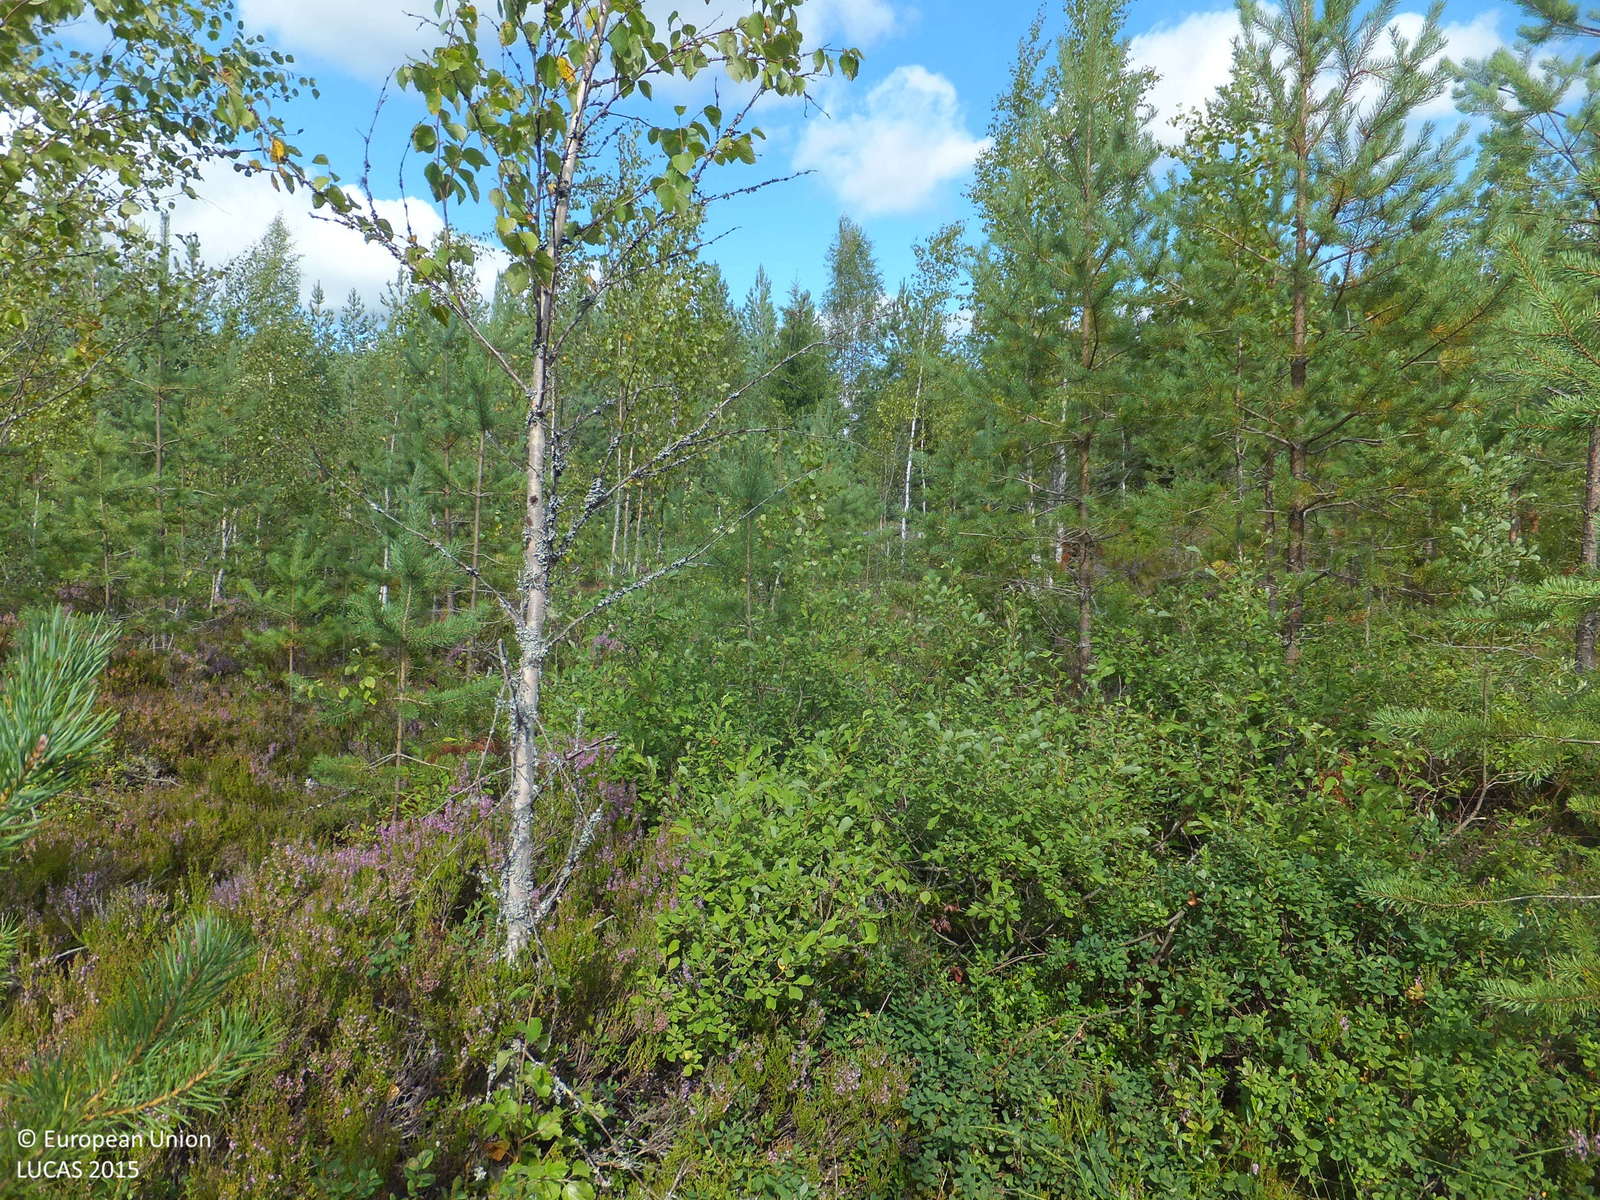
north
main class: Woodland
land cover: Pine dominated mixed woodland
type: boreal forest
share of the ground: 25 - 50 %
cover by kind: shrubs 30 %, coniferous forest trees 20 %, broadleaved forest trees 20 %, lichens and mosses 20 %, herbaceous plants 5 %, consolidated bare surface 5 %
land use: Forestry
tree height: < 5 m
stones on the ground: 10 - 25 %
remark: Nursery
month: August
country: FI
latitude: 63.2634
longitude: 22.9055
